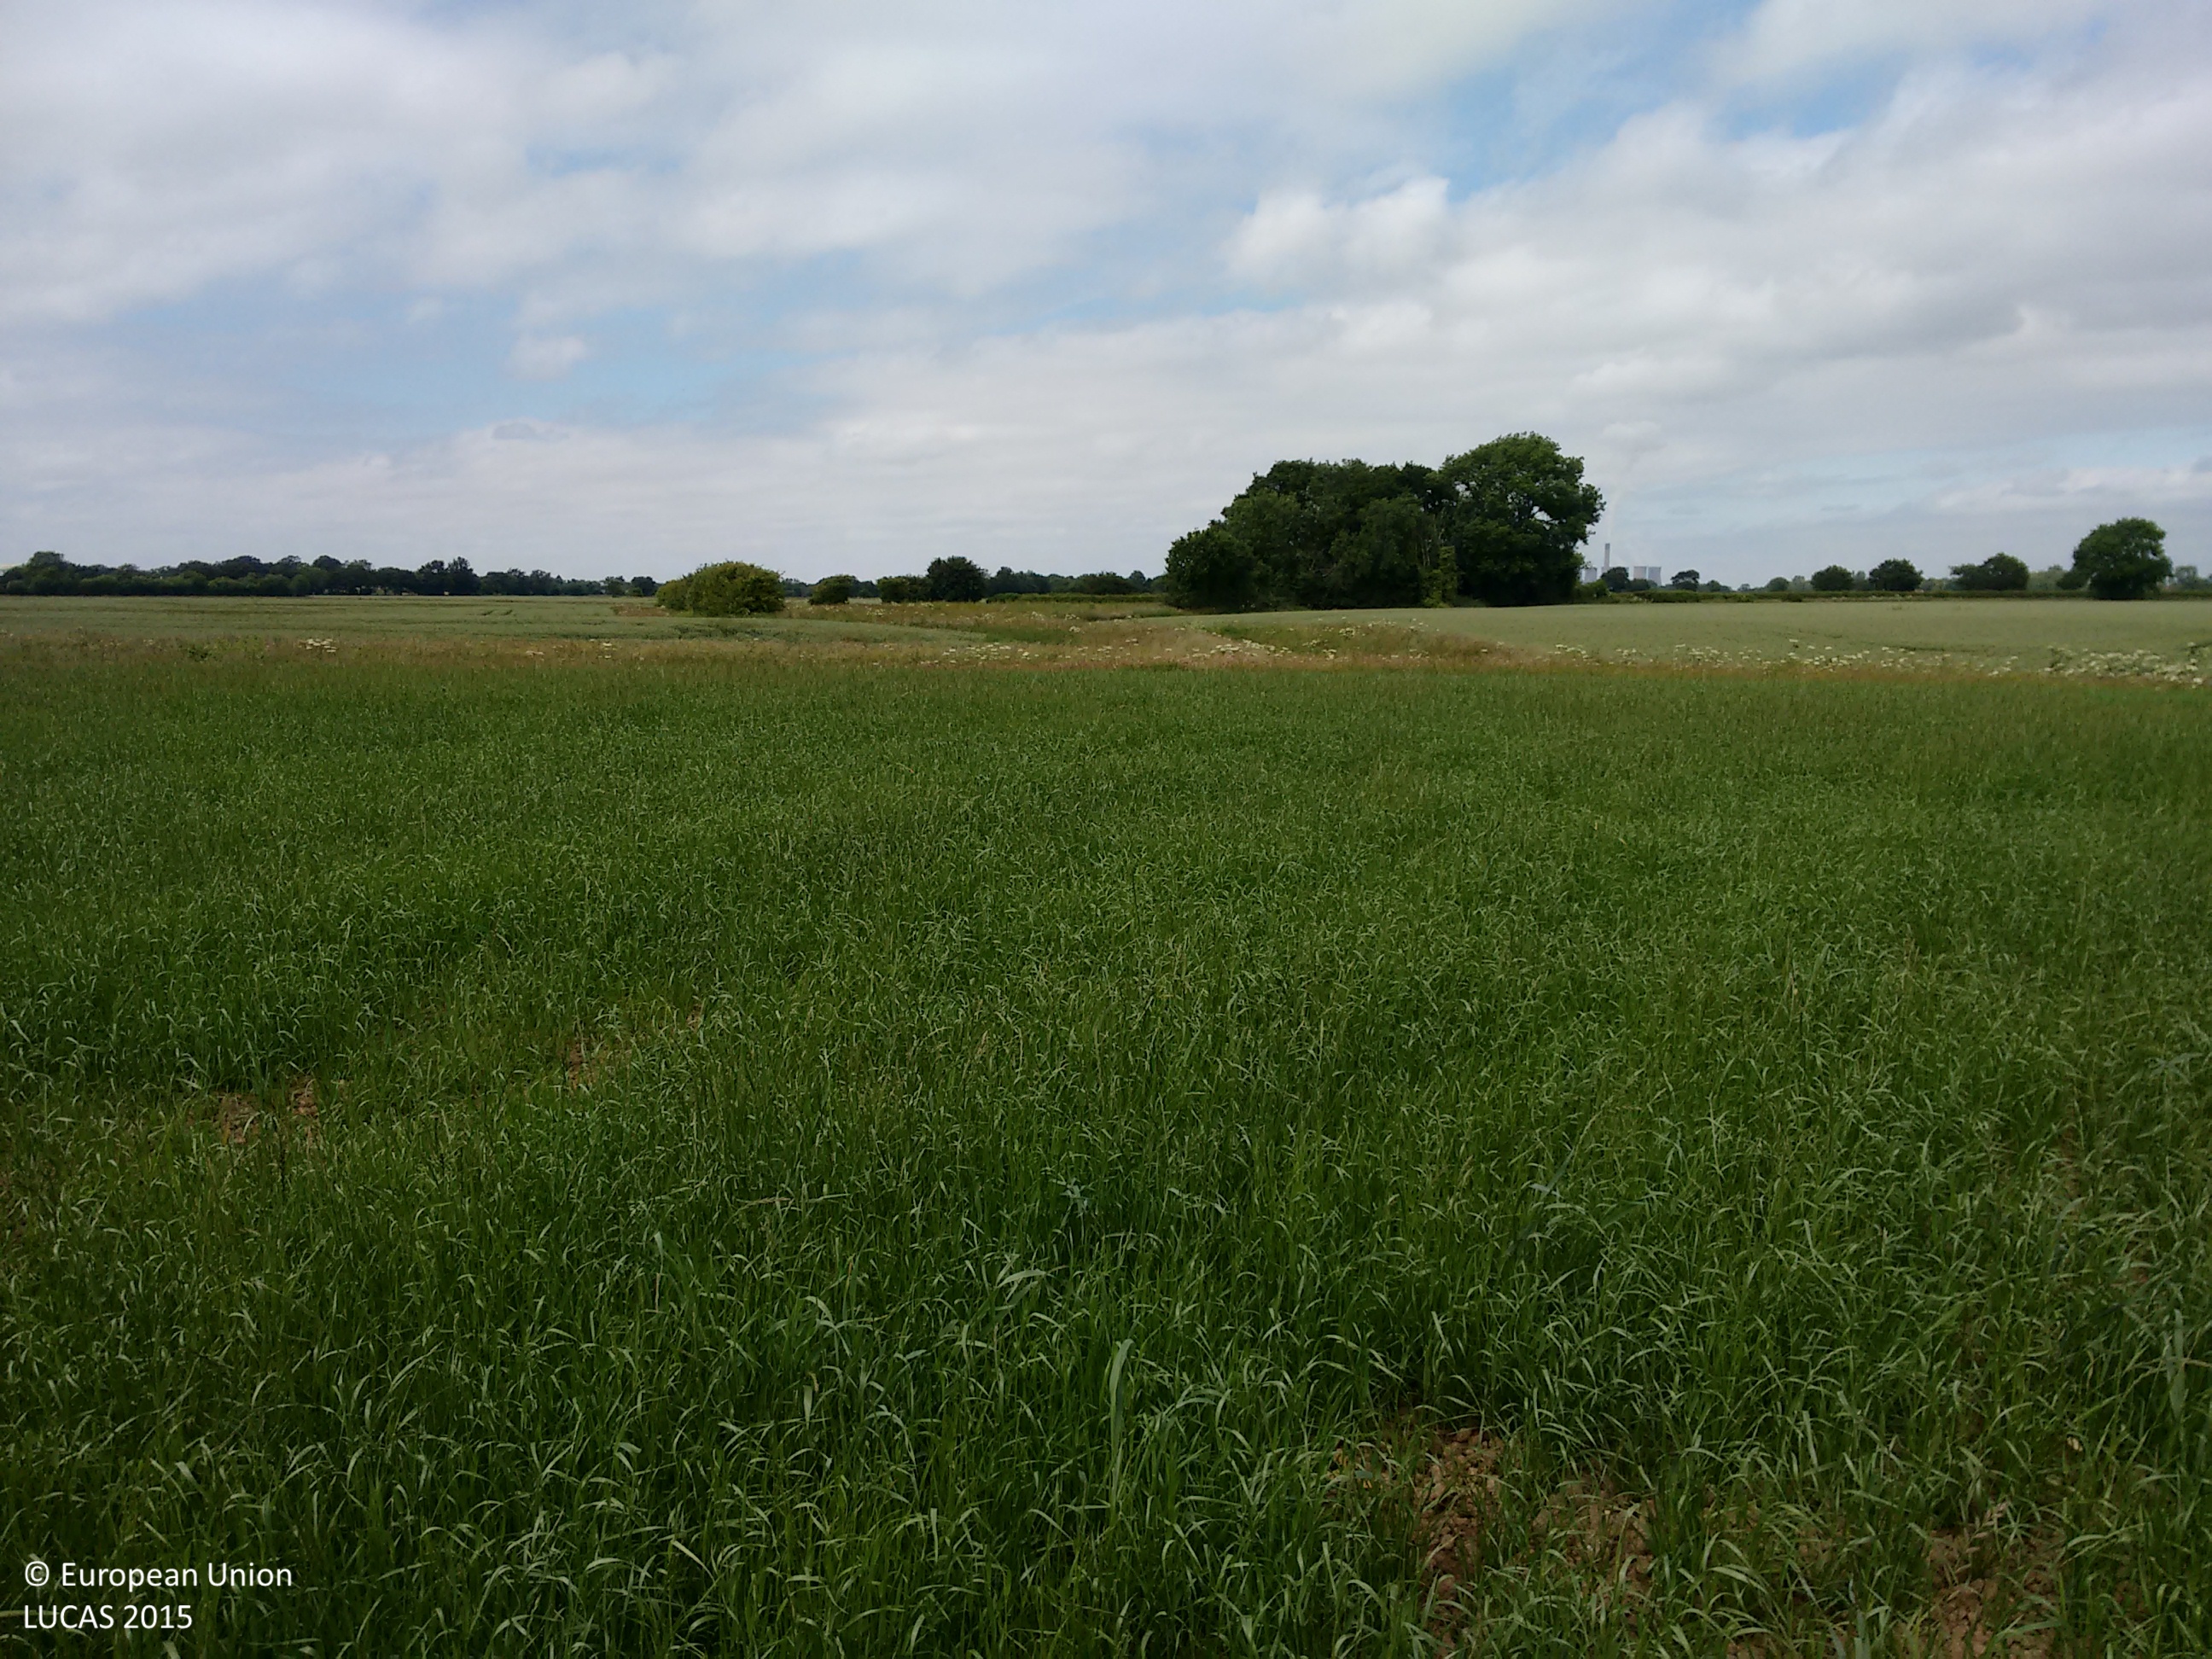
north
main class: Cropland
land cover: Barley
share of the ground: > 75 %
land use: Agriculture (excluding fallow land and kitchen gardens)
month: June
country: GB
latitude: 53.6493
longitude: -1.1342
